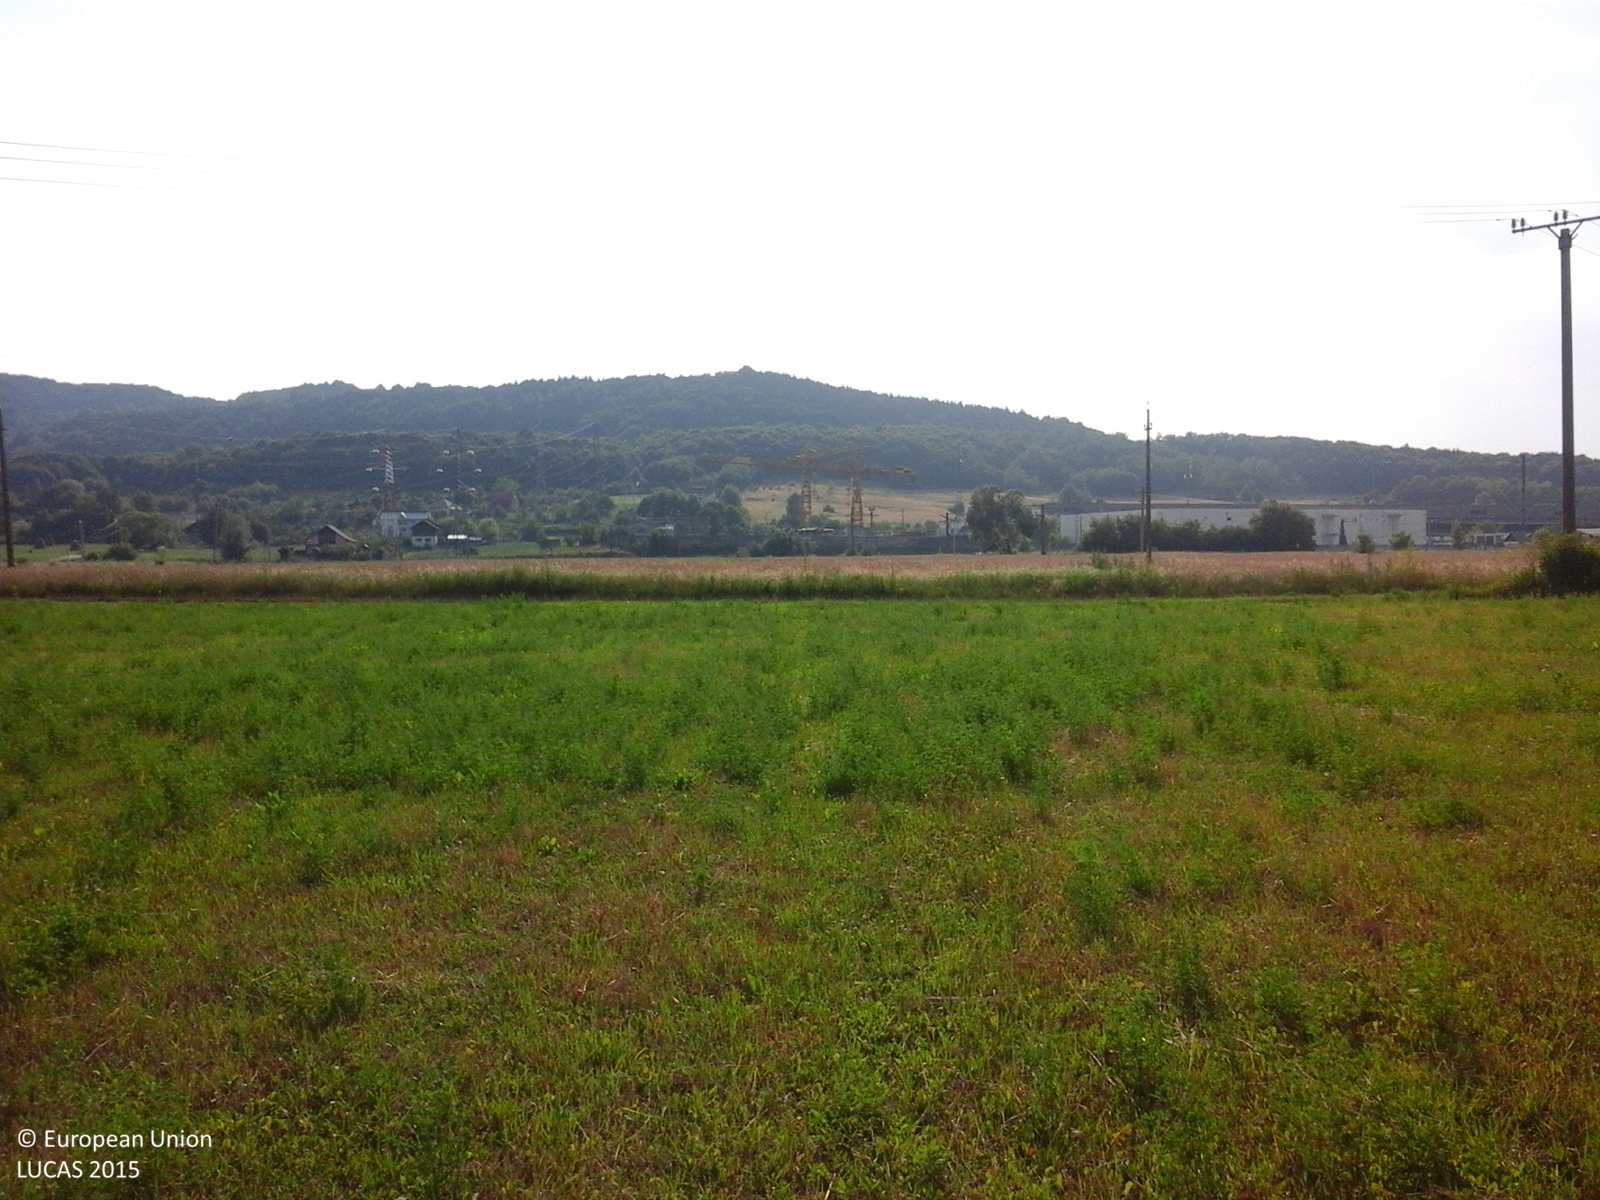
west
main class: Cropland
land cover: Lucerne
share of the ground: > 75 %
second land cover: Spontaneously vegetated surfaces
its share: 10 - 25 %
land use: Agriculture (excluding fallow land and kitchen gardens)
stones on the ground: < 10 %
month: July
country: RO
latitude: 45.1149
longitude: 24.6594
